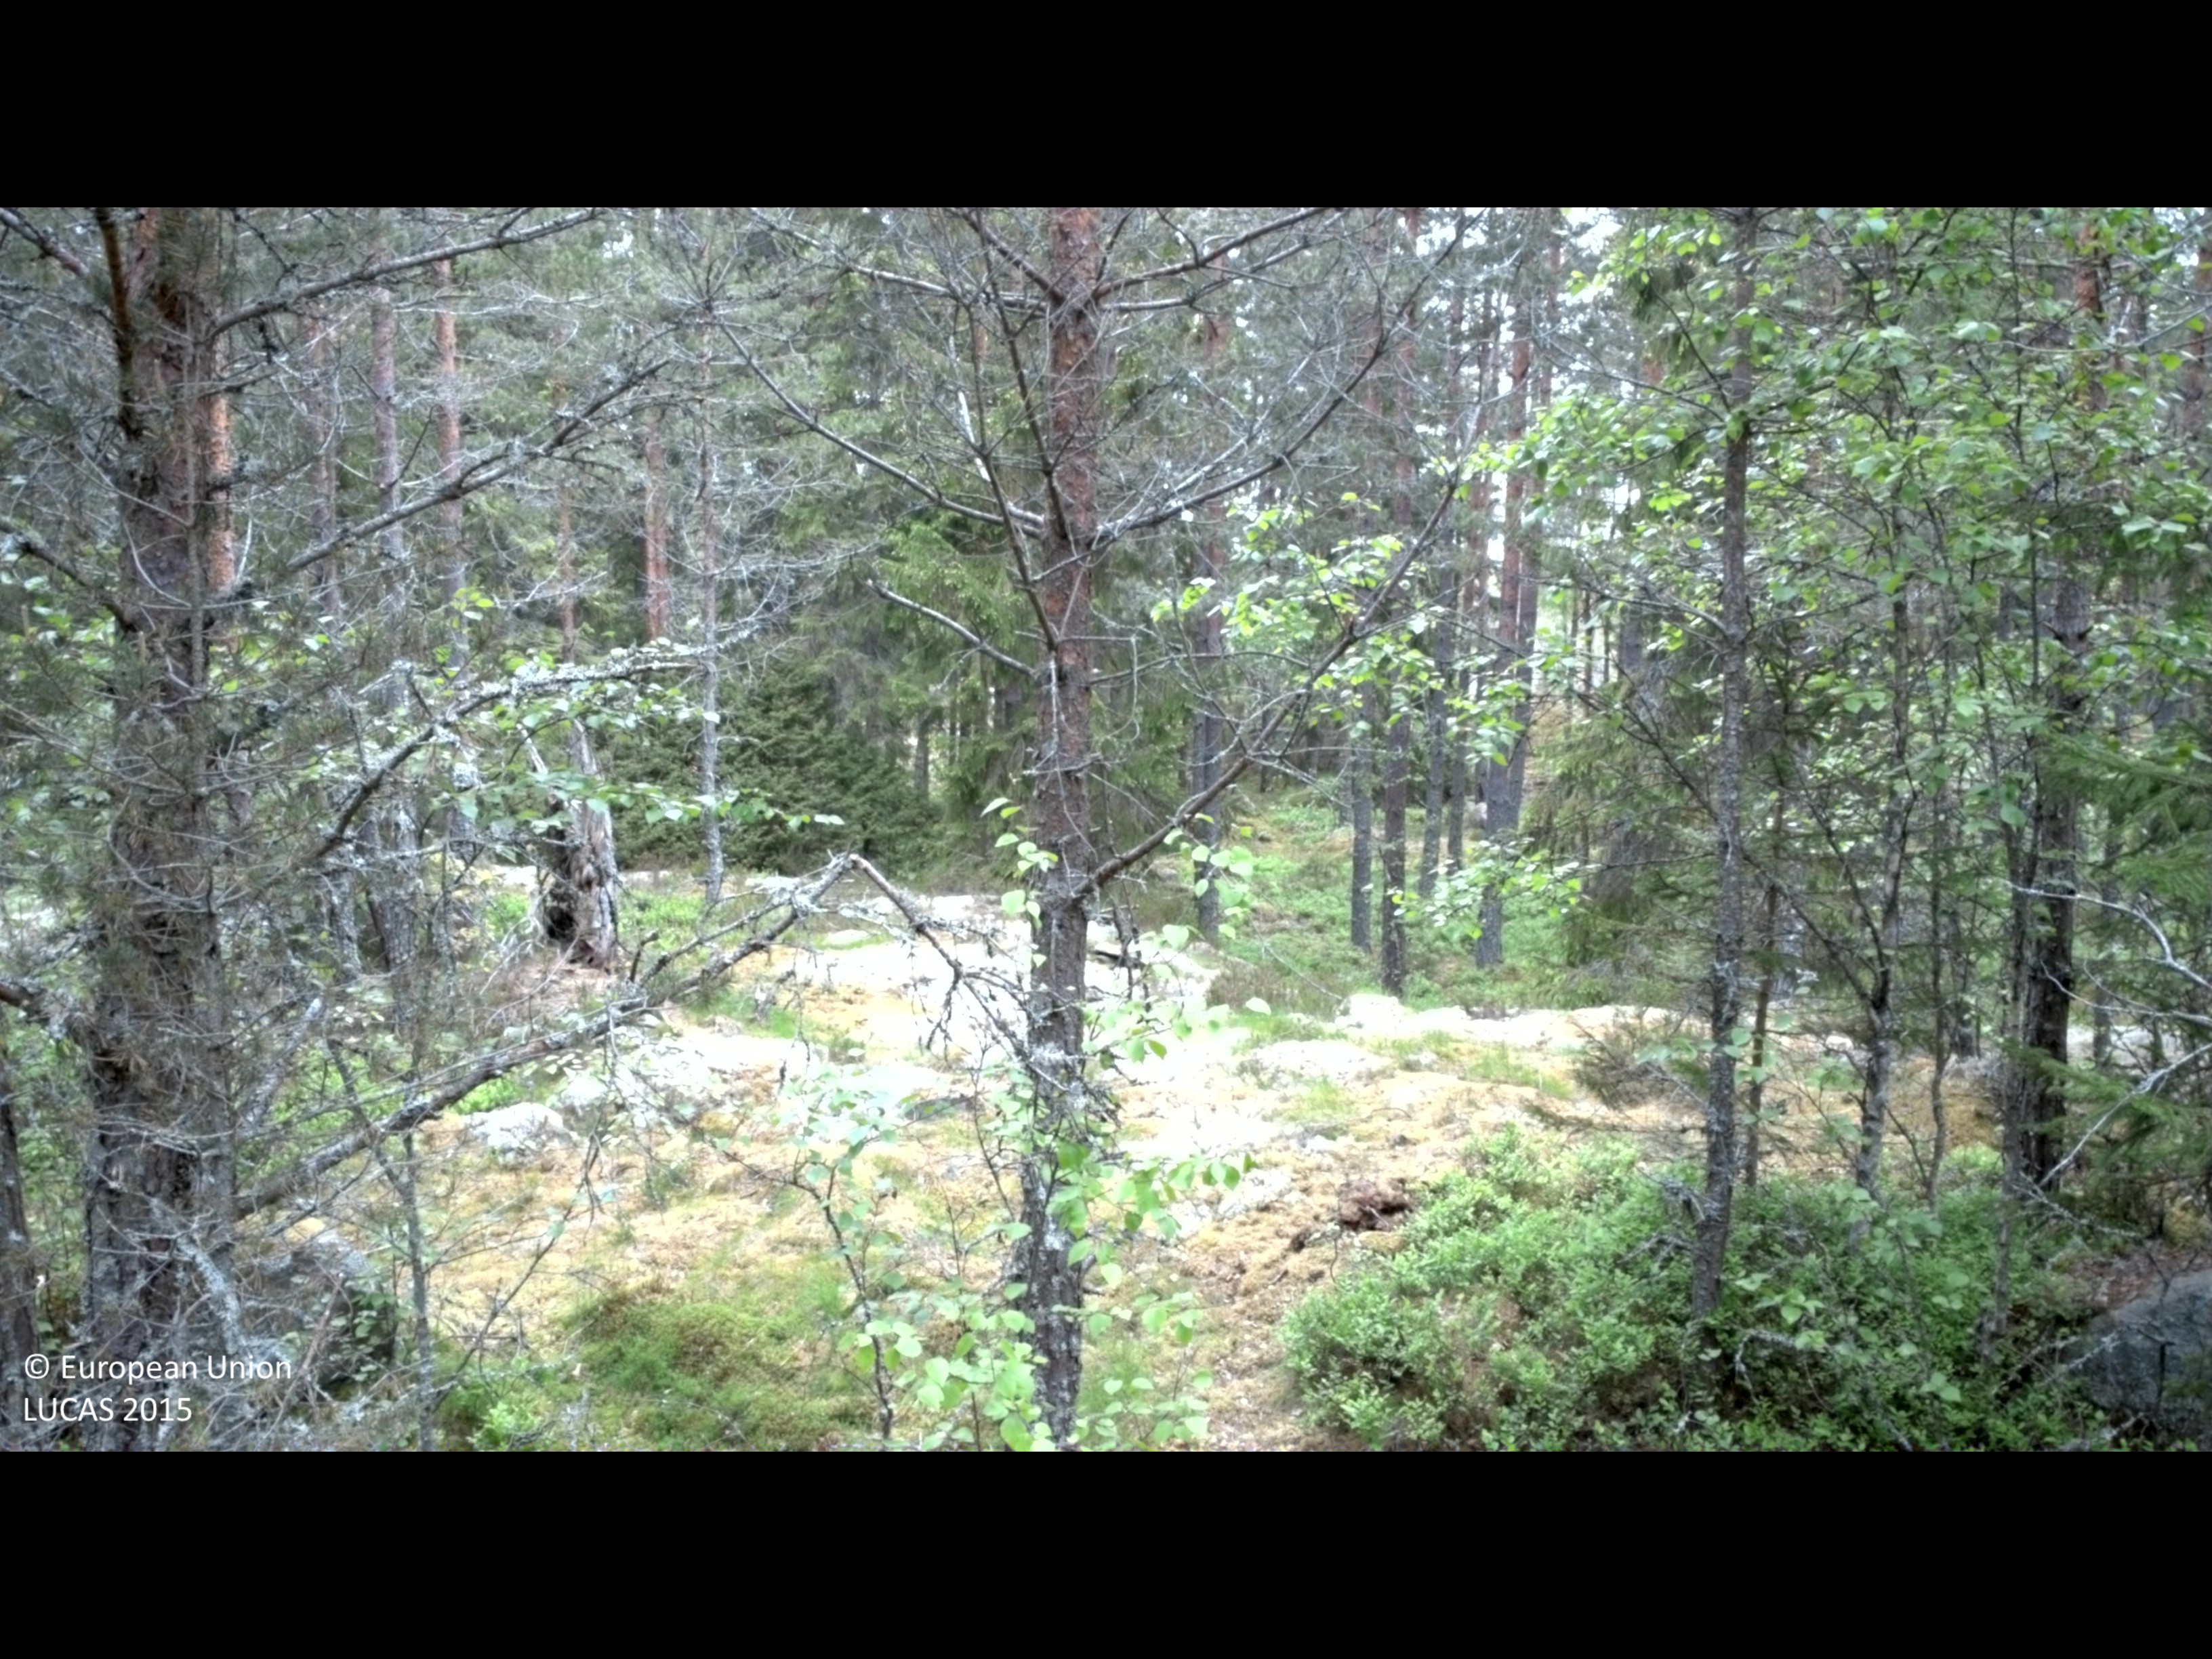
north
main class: Woodland
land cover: Pine dominated coniferous woodland
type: boreal forest
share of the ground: 25 - 50 %
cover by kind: coniferous forest trees 45 %, shrubs 30 %, lichens and mosses 20 %, broadleaved forest trees 5 %
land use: Forestry
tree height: > 5 m
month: June
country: SE
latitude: 57.6770
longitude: 16.2526
